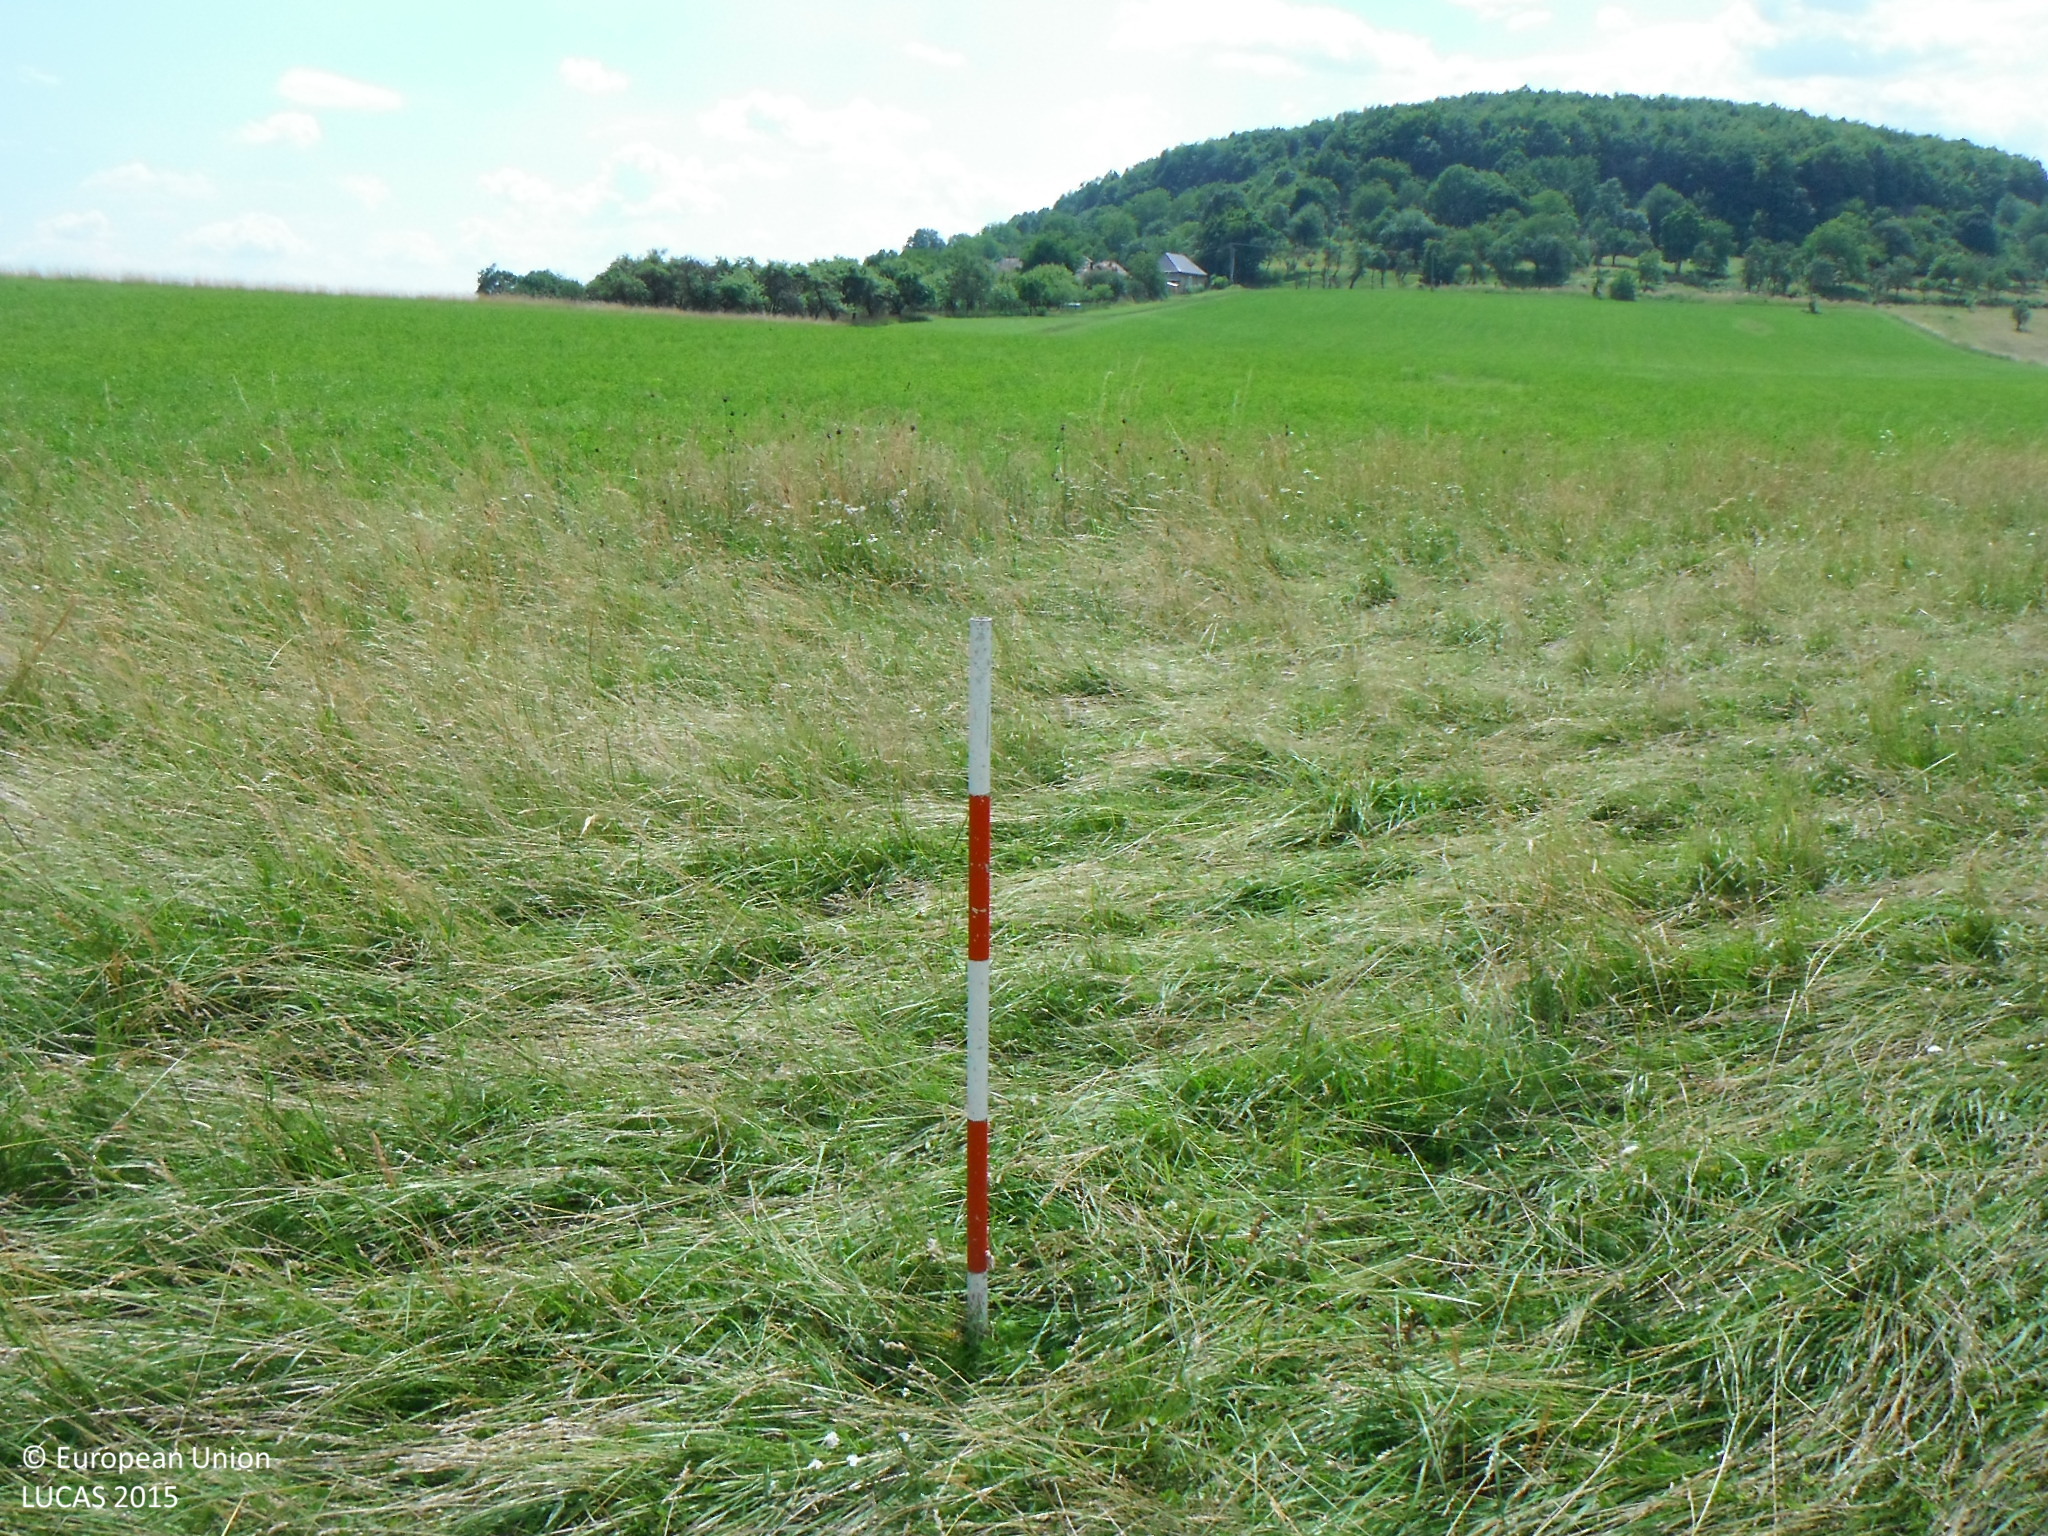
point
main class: Grassland
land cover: Grassland without tree/shrub cover
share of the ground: > 75 %
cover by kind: herbaceous plants 100 %
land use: Agriculture (excluding fallow land and kitchen gardens)
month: June
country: SK
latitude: 48.5210
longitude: 20.0902
